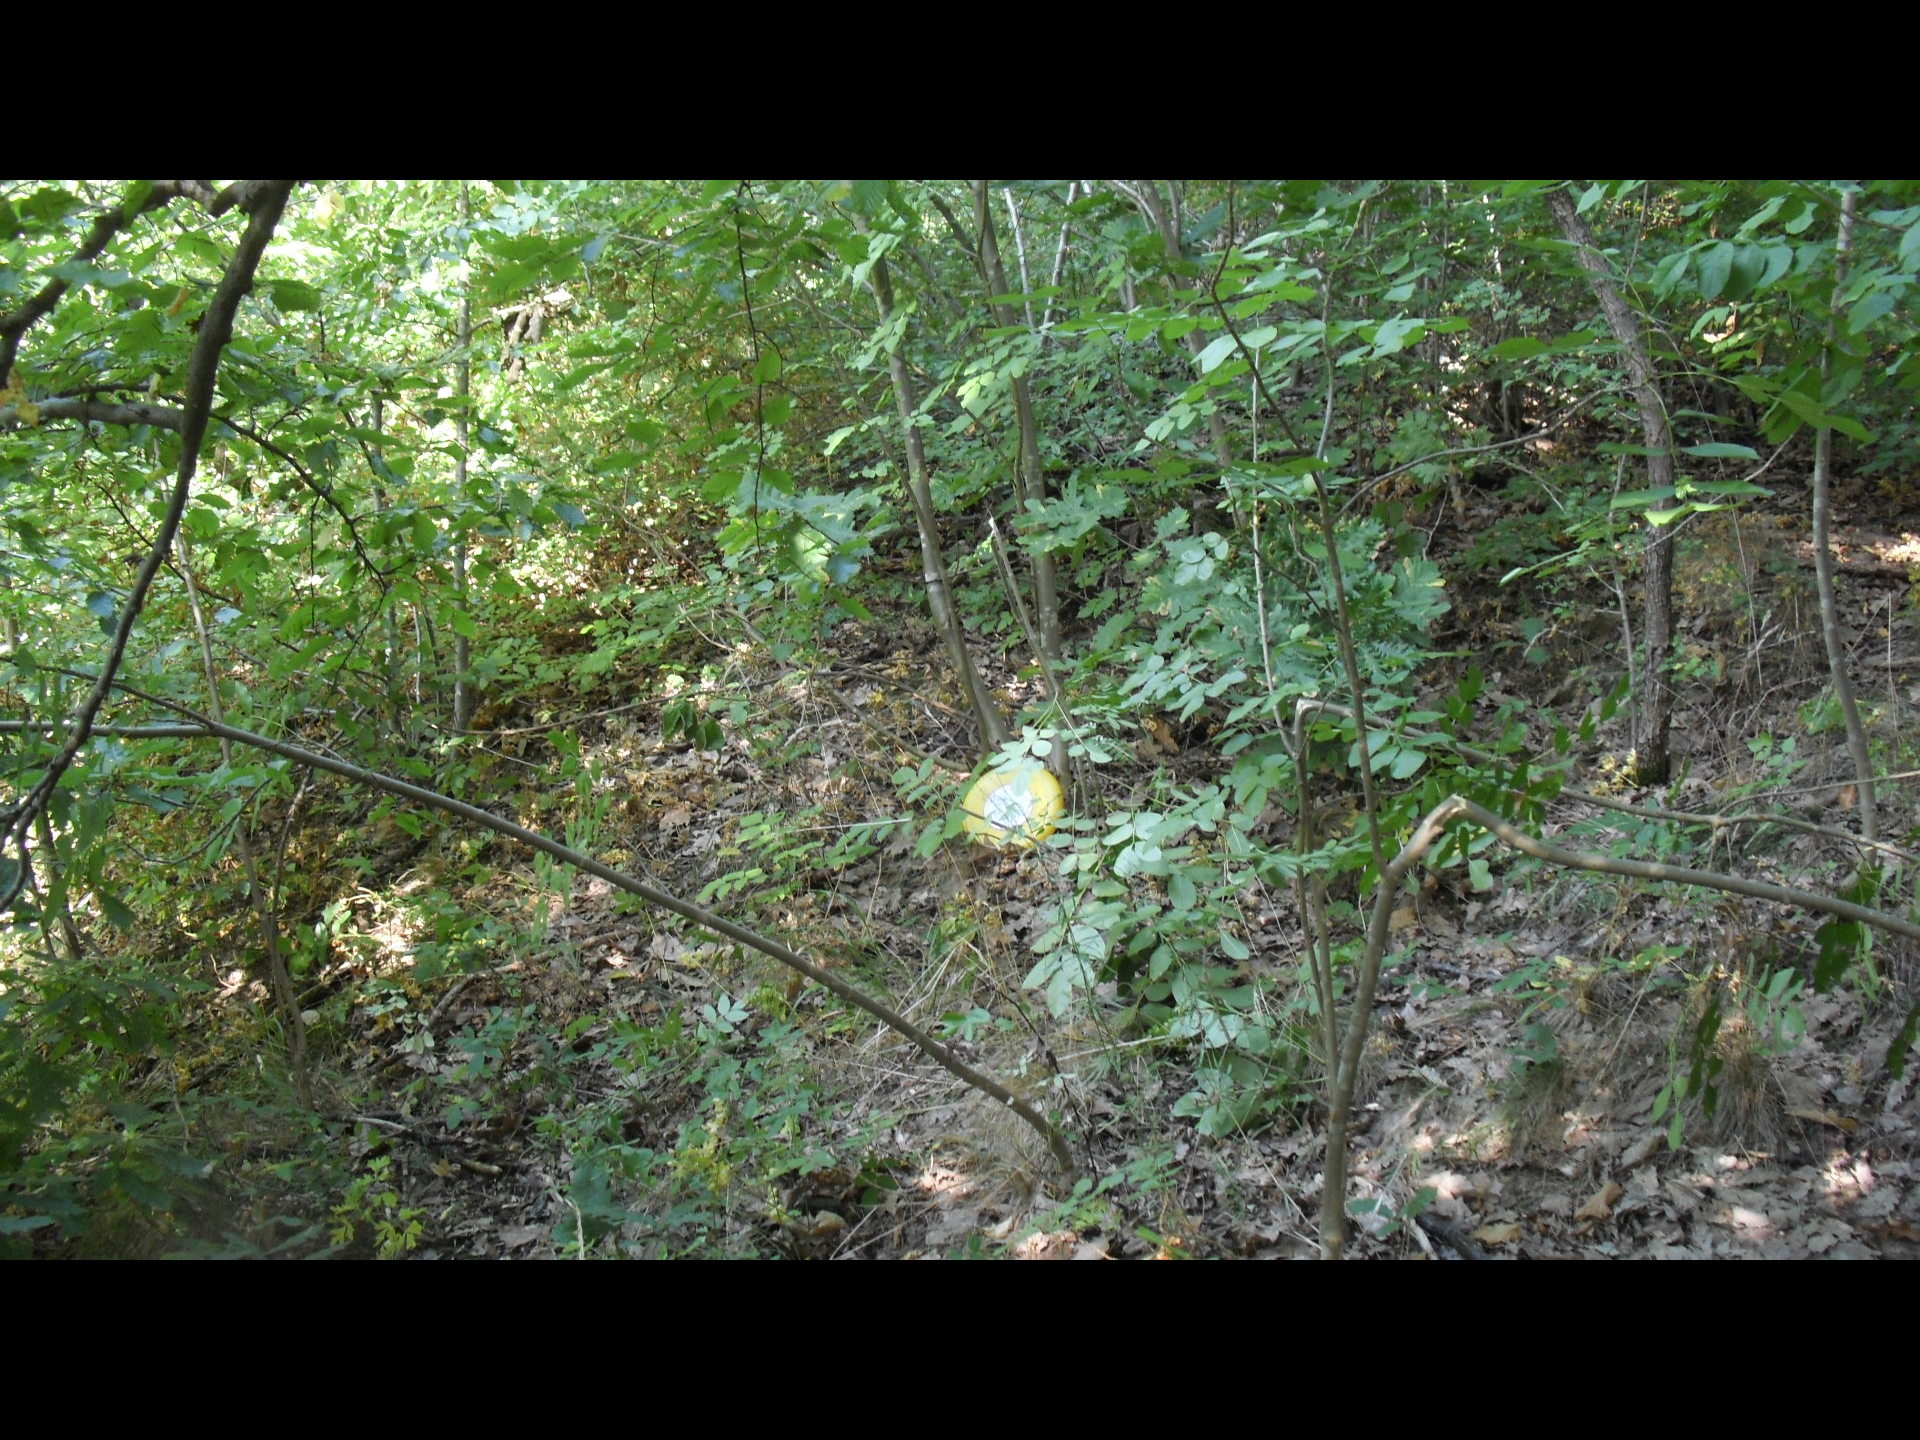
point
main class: Woodland
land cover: Broadleaved woodland
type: mesophytic deciduous forest
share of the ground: > 75 %
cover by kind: broadleaved forest trees 95 %, herbaceous plants 5 %
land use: Forestry
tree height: > 5 m
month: August
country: BG
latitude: 43.3033
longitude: 23.1916
